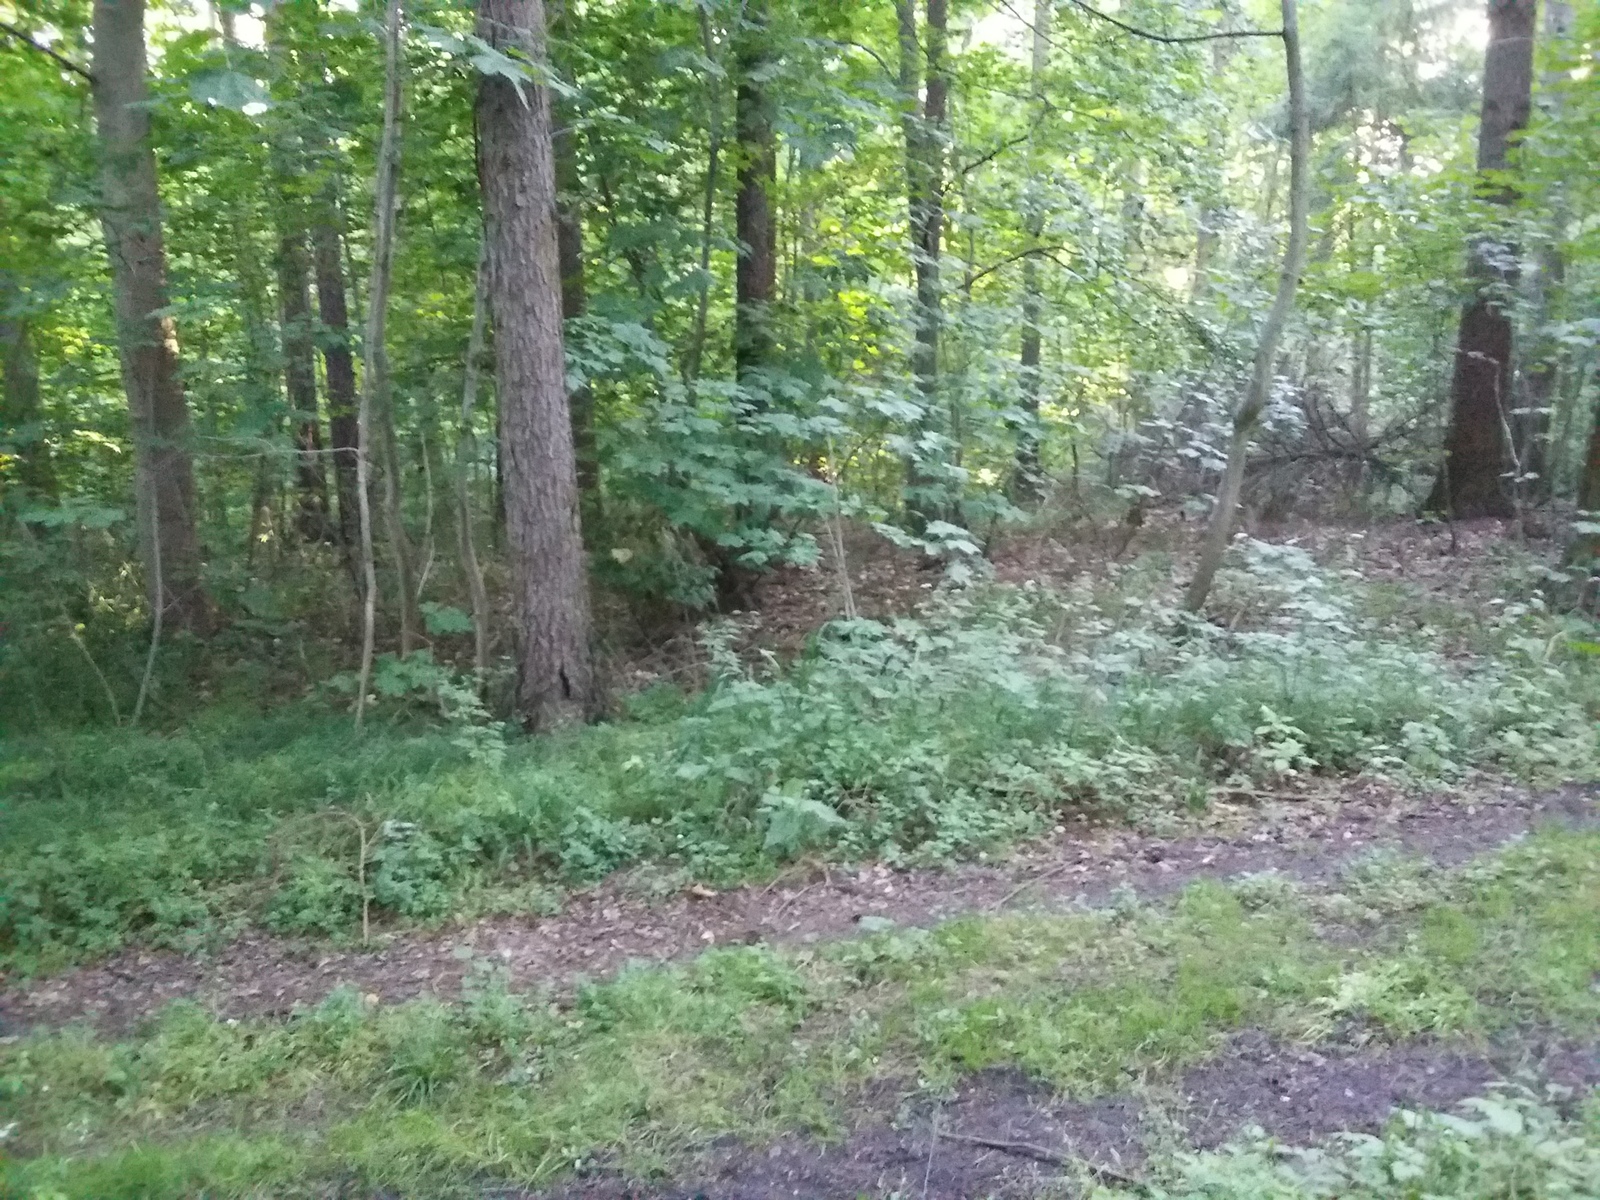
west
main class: Woodland
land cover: Spruce dominated mixed woodland
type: thermophilous deciduous forest
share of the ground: > 75 %
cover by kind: coniferous forest trees 65 %, broadleaved forest trees 25 %, herbaceous plants 10 %
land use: Forestry
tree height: > 5 m
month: July
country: DK
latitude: 54.9673
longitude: 12.0137
